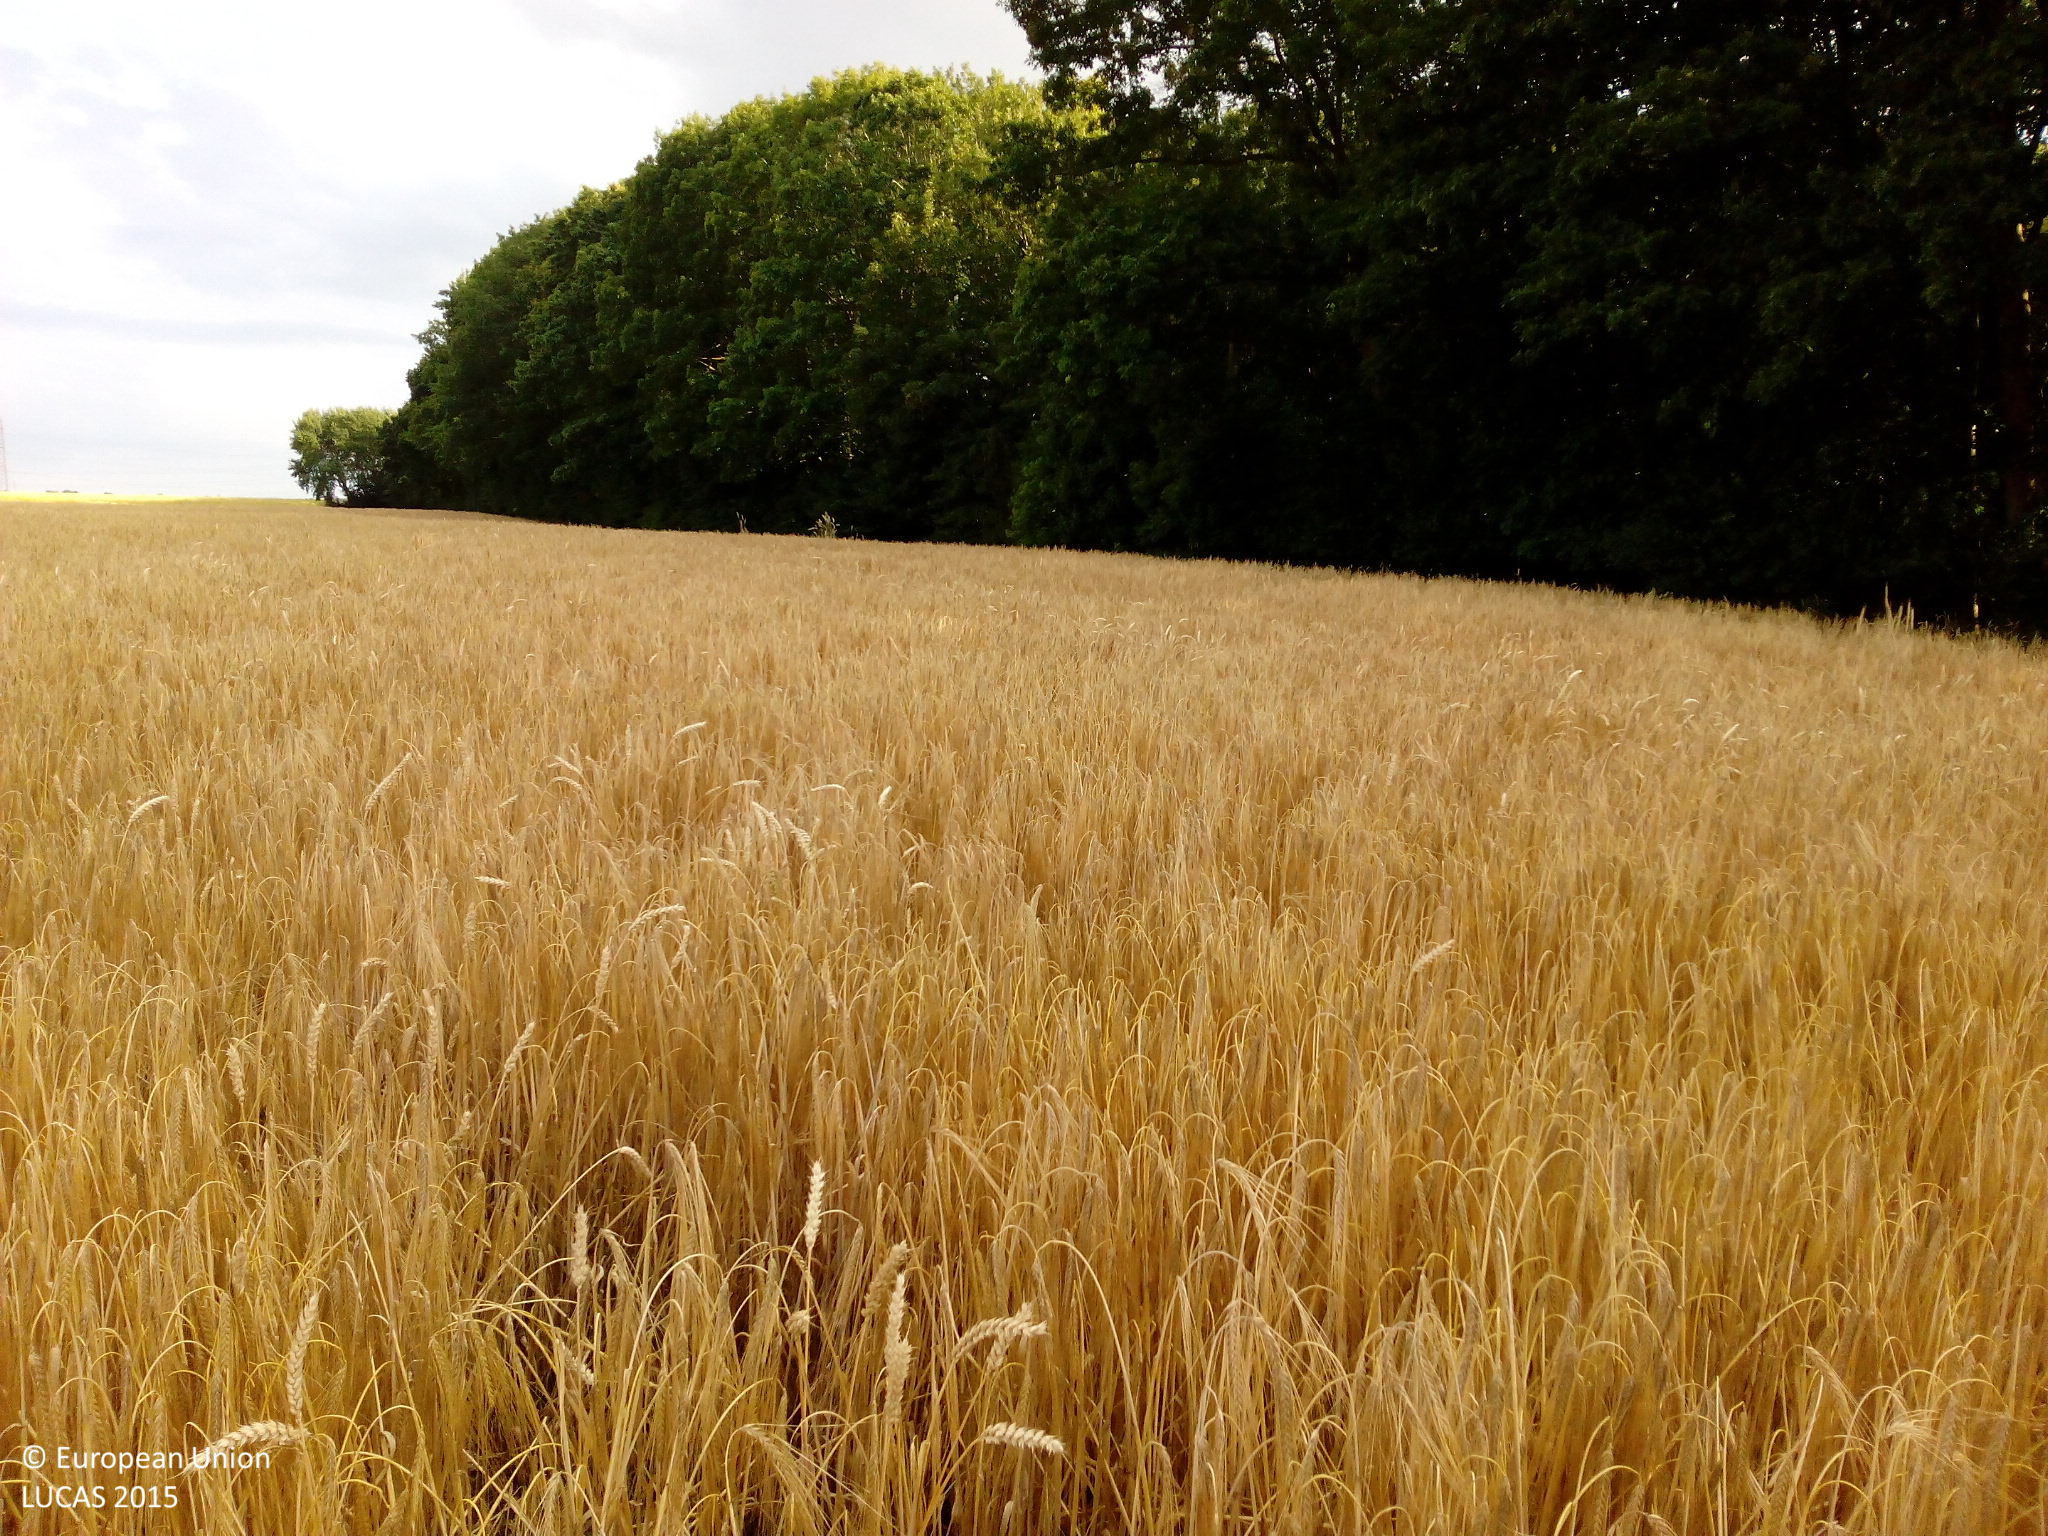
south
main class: Cropland
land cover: Barley
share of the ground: > 75 %
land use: Agriculture (excluding fallow land and kitchen gardens)
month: July
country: DK
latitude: 55.8141
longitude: 11.8972
